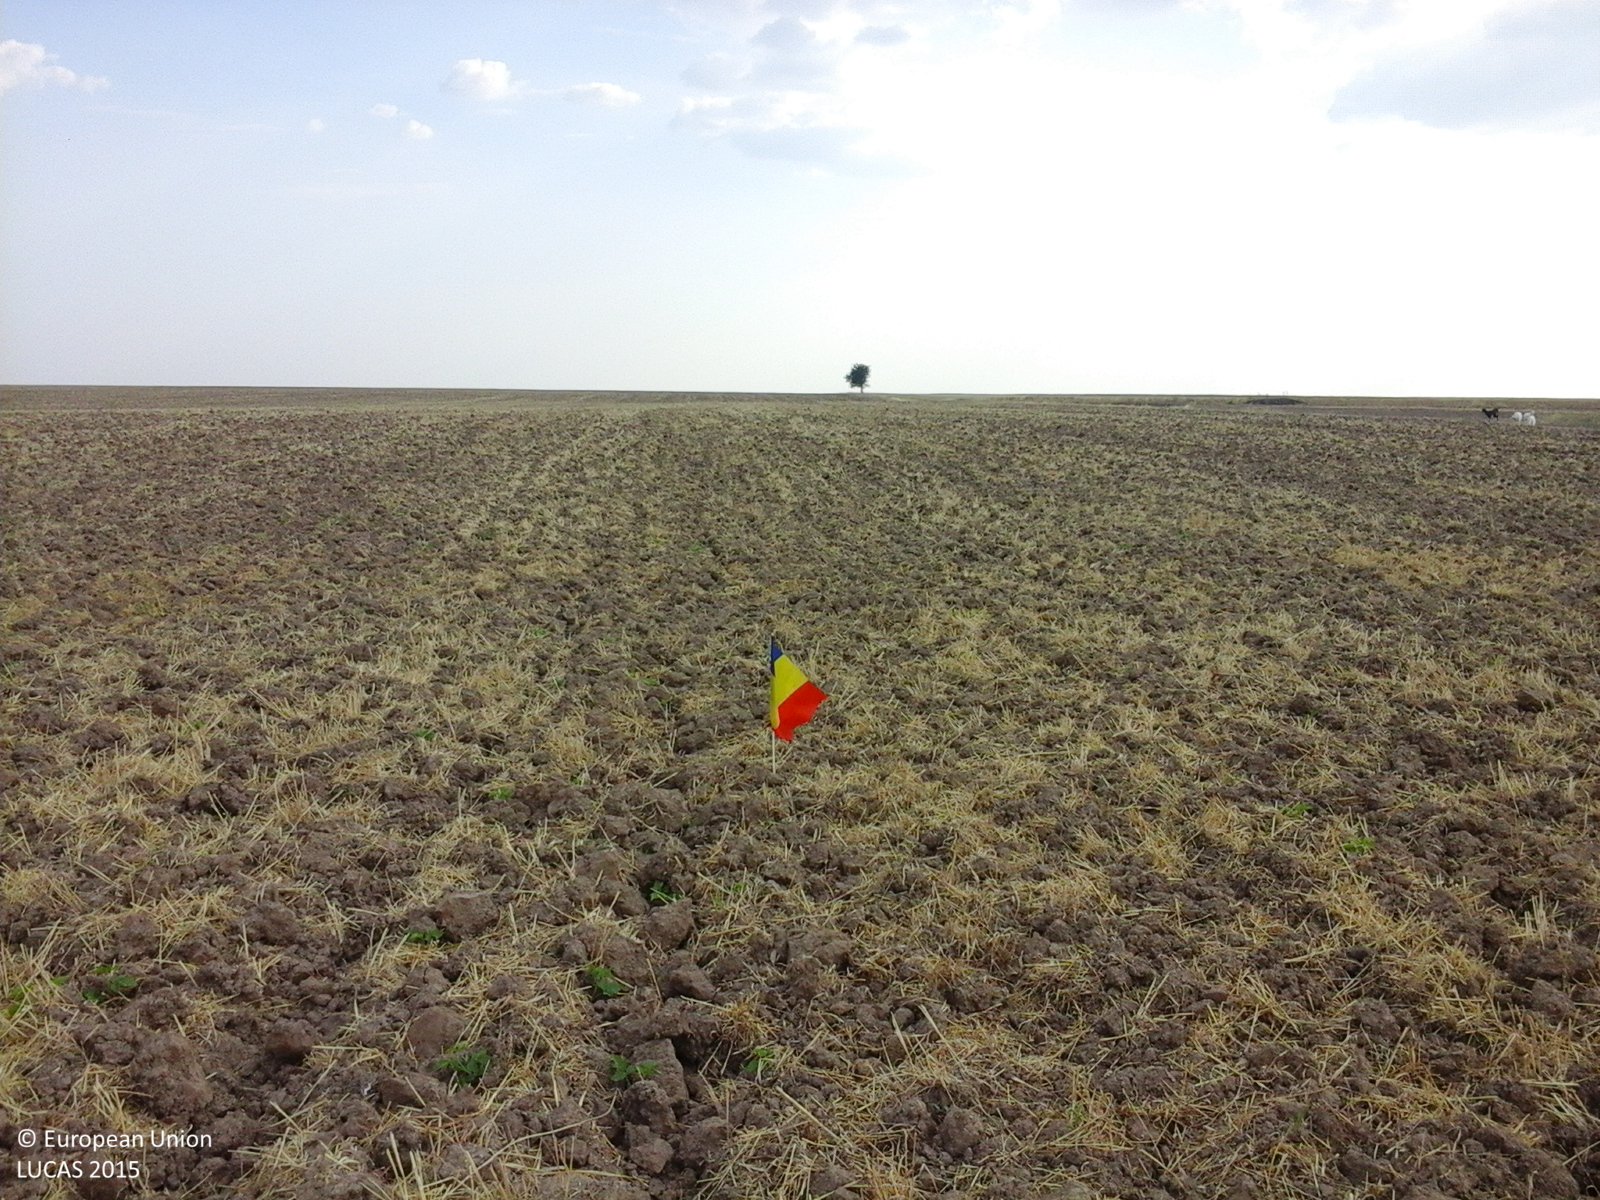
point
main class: Cropland
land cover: Durum wheat
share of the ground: 10 - 25 %
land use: Agriculture (excluding fallow land and kitchen gardens)
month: August
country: RO
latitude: 44.2808
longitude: 23.1144
